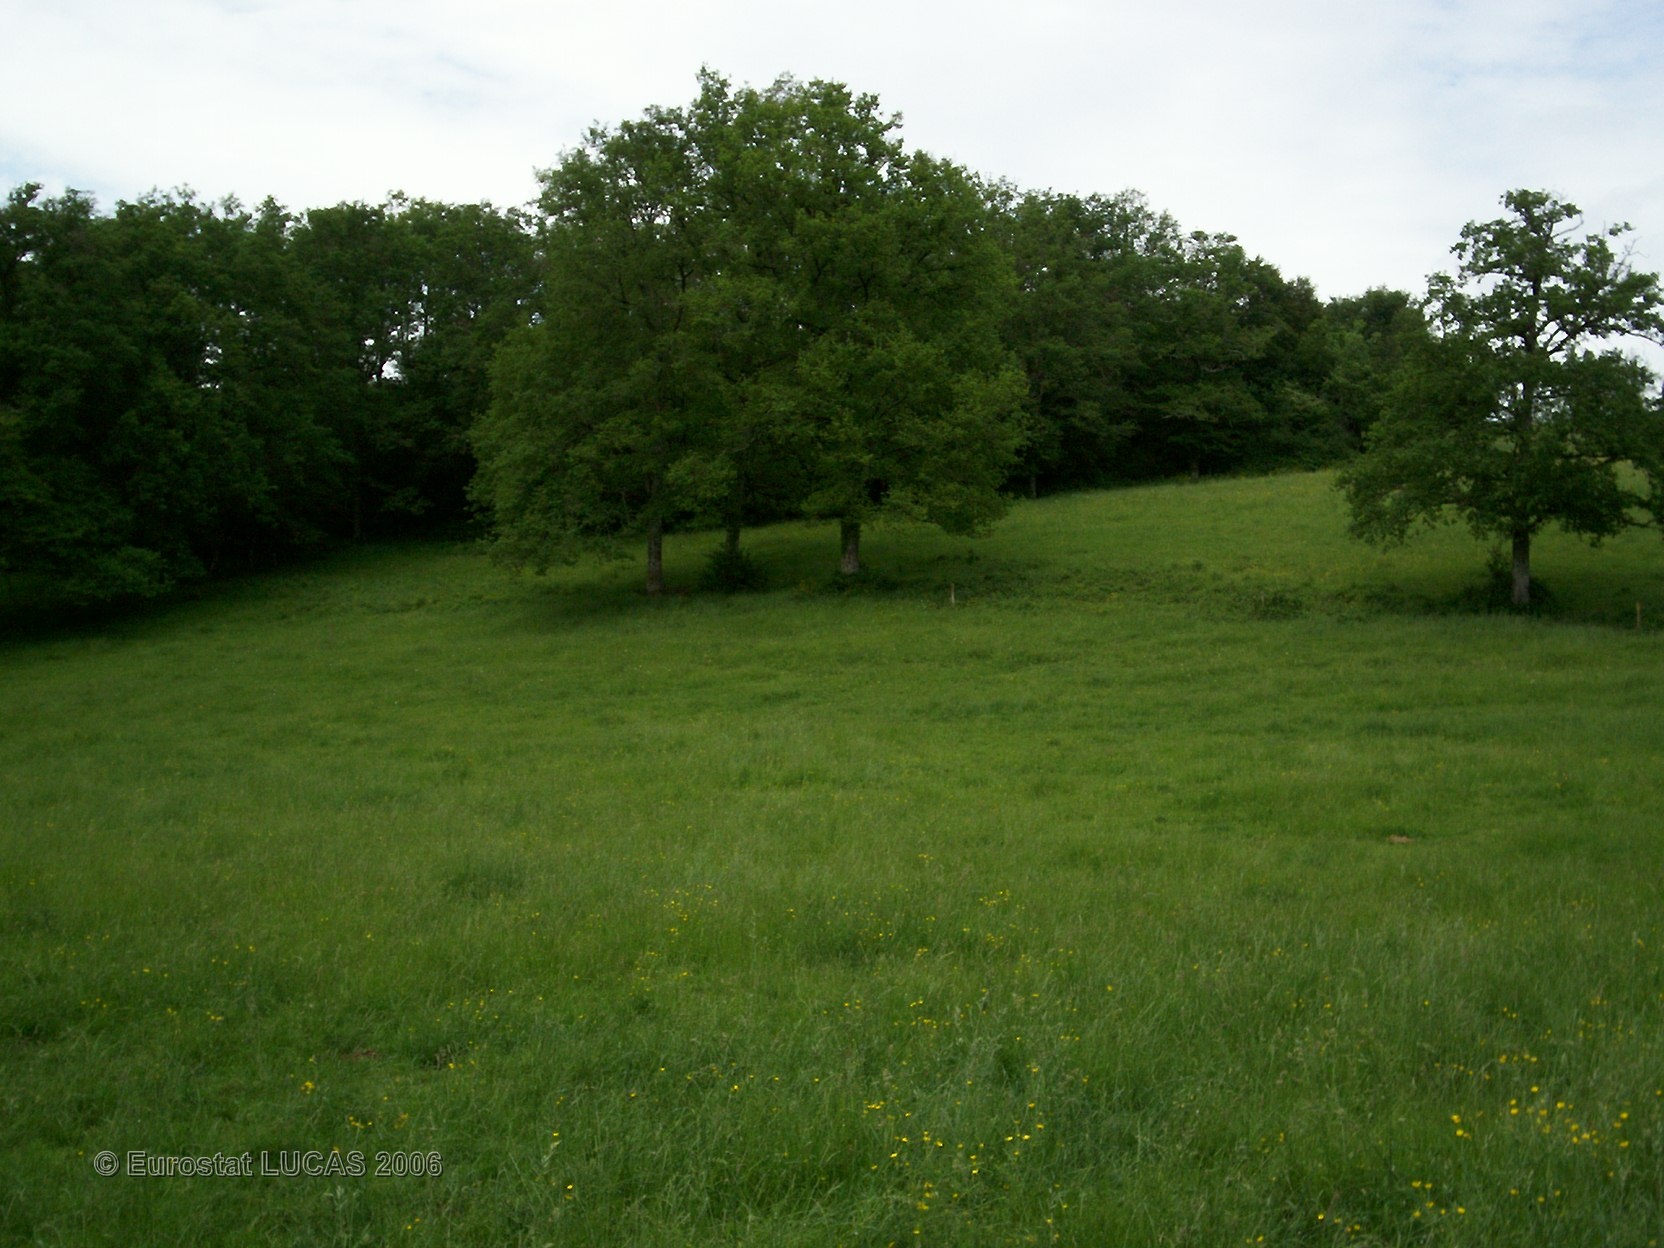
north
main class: Grassland
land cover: Grassland without tree/shrub cover
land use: Agriculture (excluding fallow land and kitchen gardens)
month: May
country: FR
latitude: 45.8210
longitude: 0.5255
